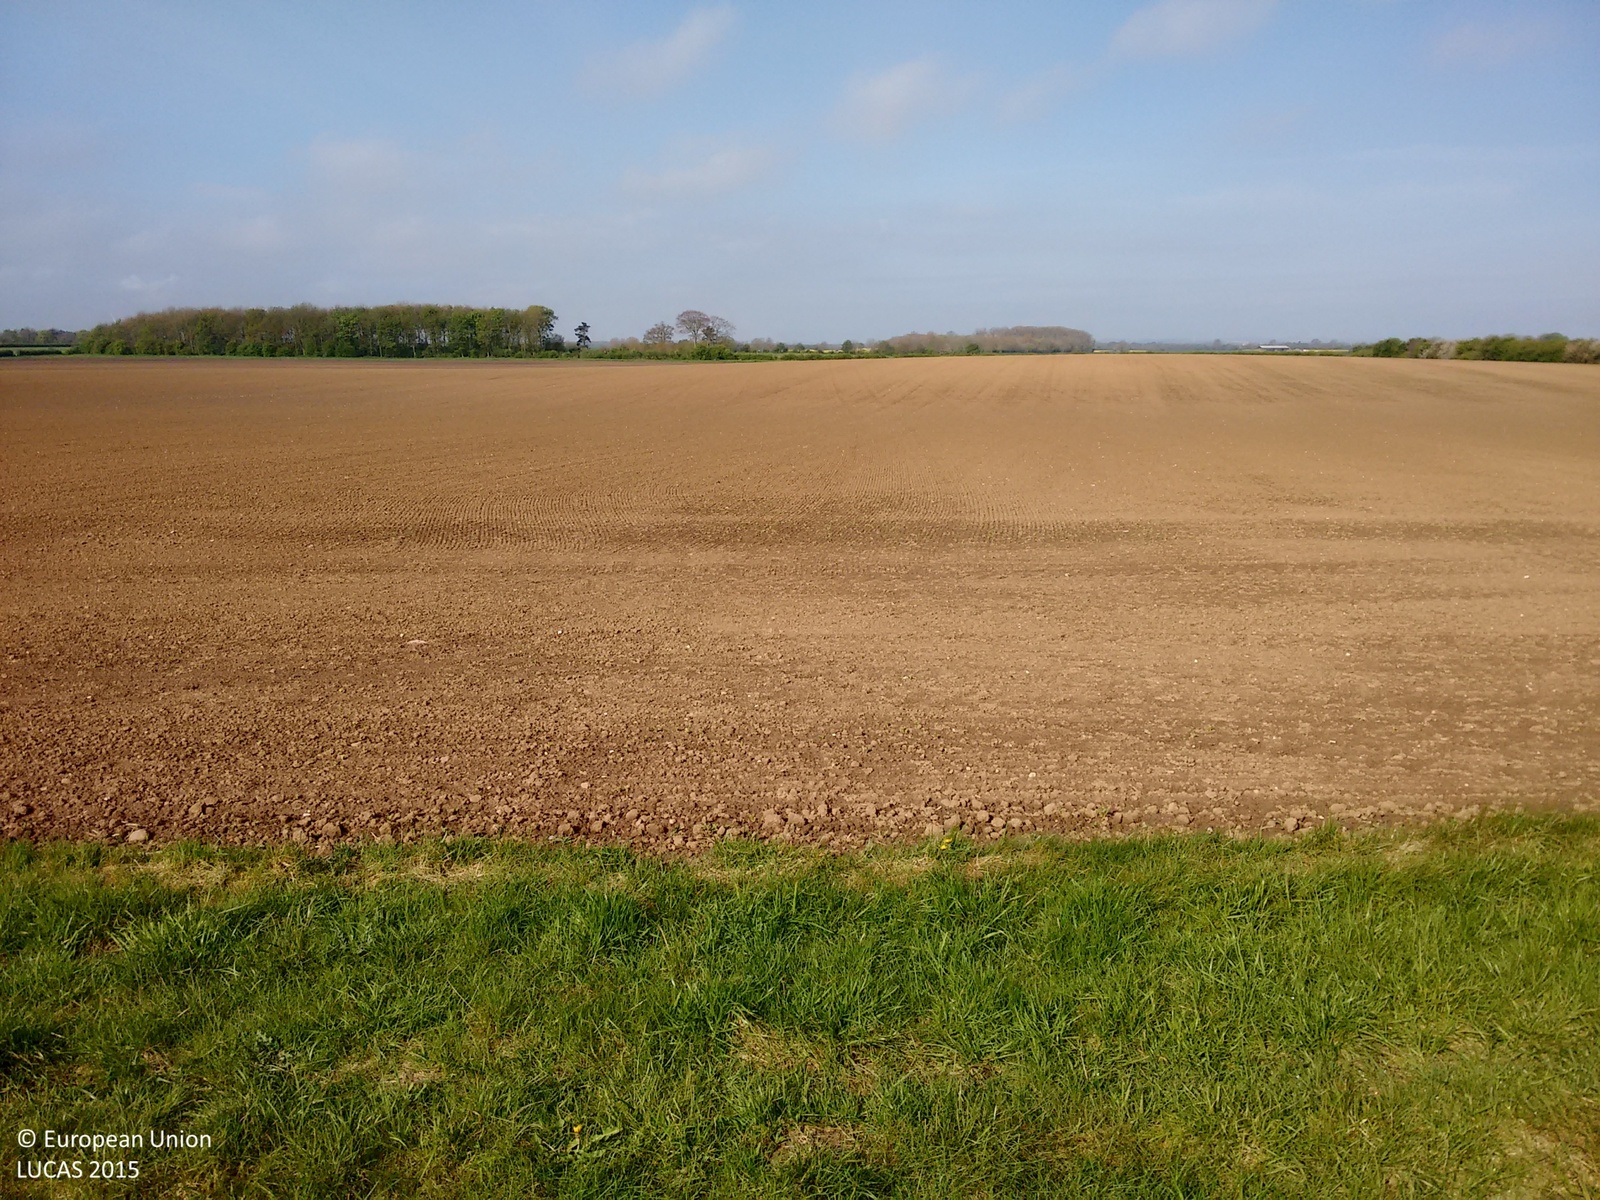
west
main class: Grassland
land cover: Grassland without tree/shrub cover
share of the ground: > 75 %
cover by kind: herbaceous plants 100 %
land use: Agriculture (excluding fallow land and kitchen gardens)
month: May
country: GB
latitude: 53.9924
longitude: -0.3303
